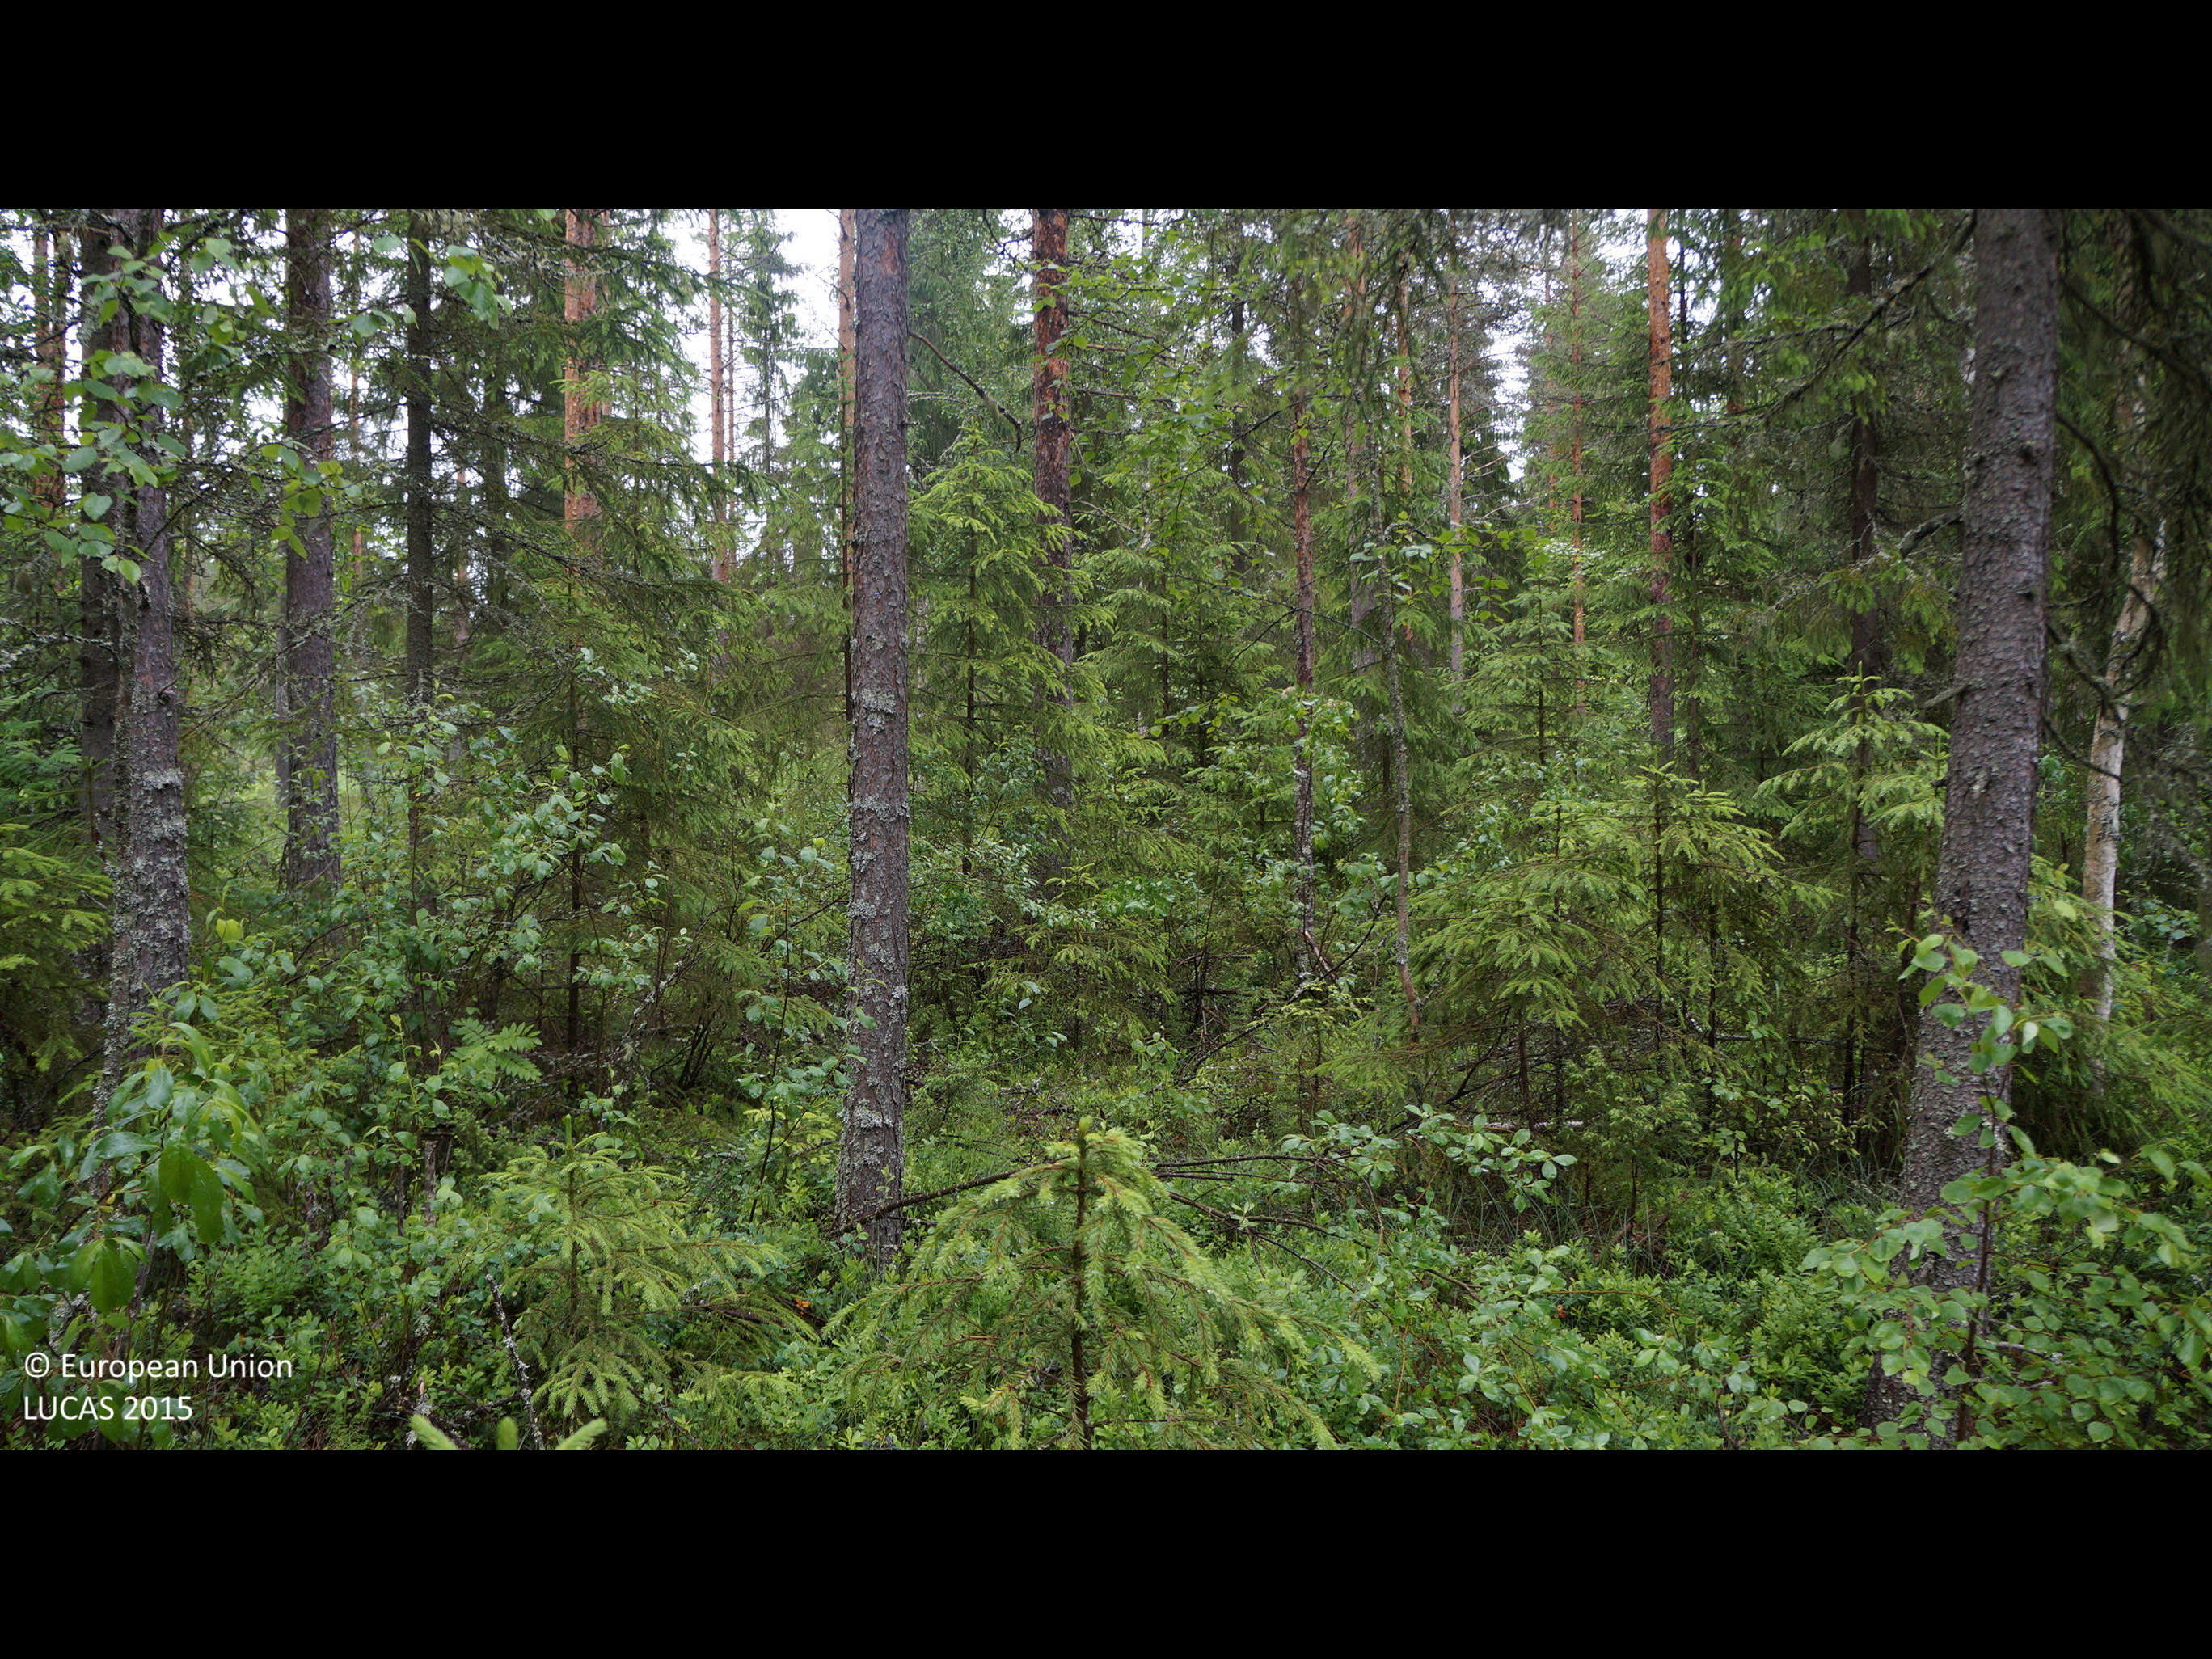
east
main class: Woodland
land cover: Spruce dominated coniferous woodland
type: boreal forest
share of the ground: 50 - 75 %
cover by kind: coniferous forest trees 60 %, shrubs 30 %, broadleaved forest trees 5 %, herbaceous plants 5 %
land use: Forestry
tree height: > 5 m
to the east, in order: Spruce dominated coniferous woodland; Ditches and canals; Pine dominated coniferous woodland; Spruce dominated coniferous woodland; Ditches and canals; Spruce dominated coniferous woodland; Broadleaved woodland; Spruce dominated coniferous woodland; Broadleaved woodland; Spruce dominated coniferous woodland; Broadleaved woodland; Ditches and canals; Spruce dominated coniferous woodland; Ditches and canals; Shruby margins; Tracks; Shruby margins; Ditches and canals; Spruce dominated coniferous woodland
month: June
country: FI
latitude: 64.3323
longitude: 24.5353
